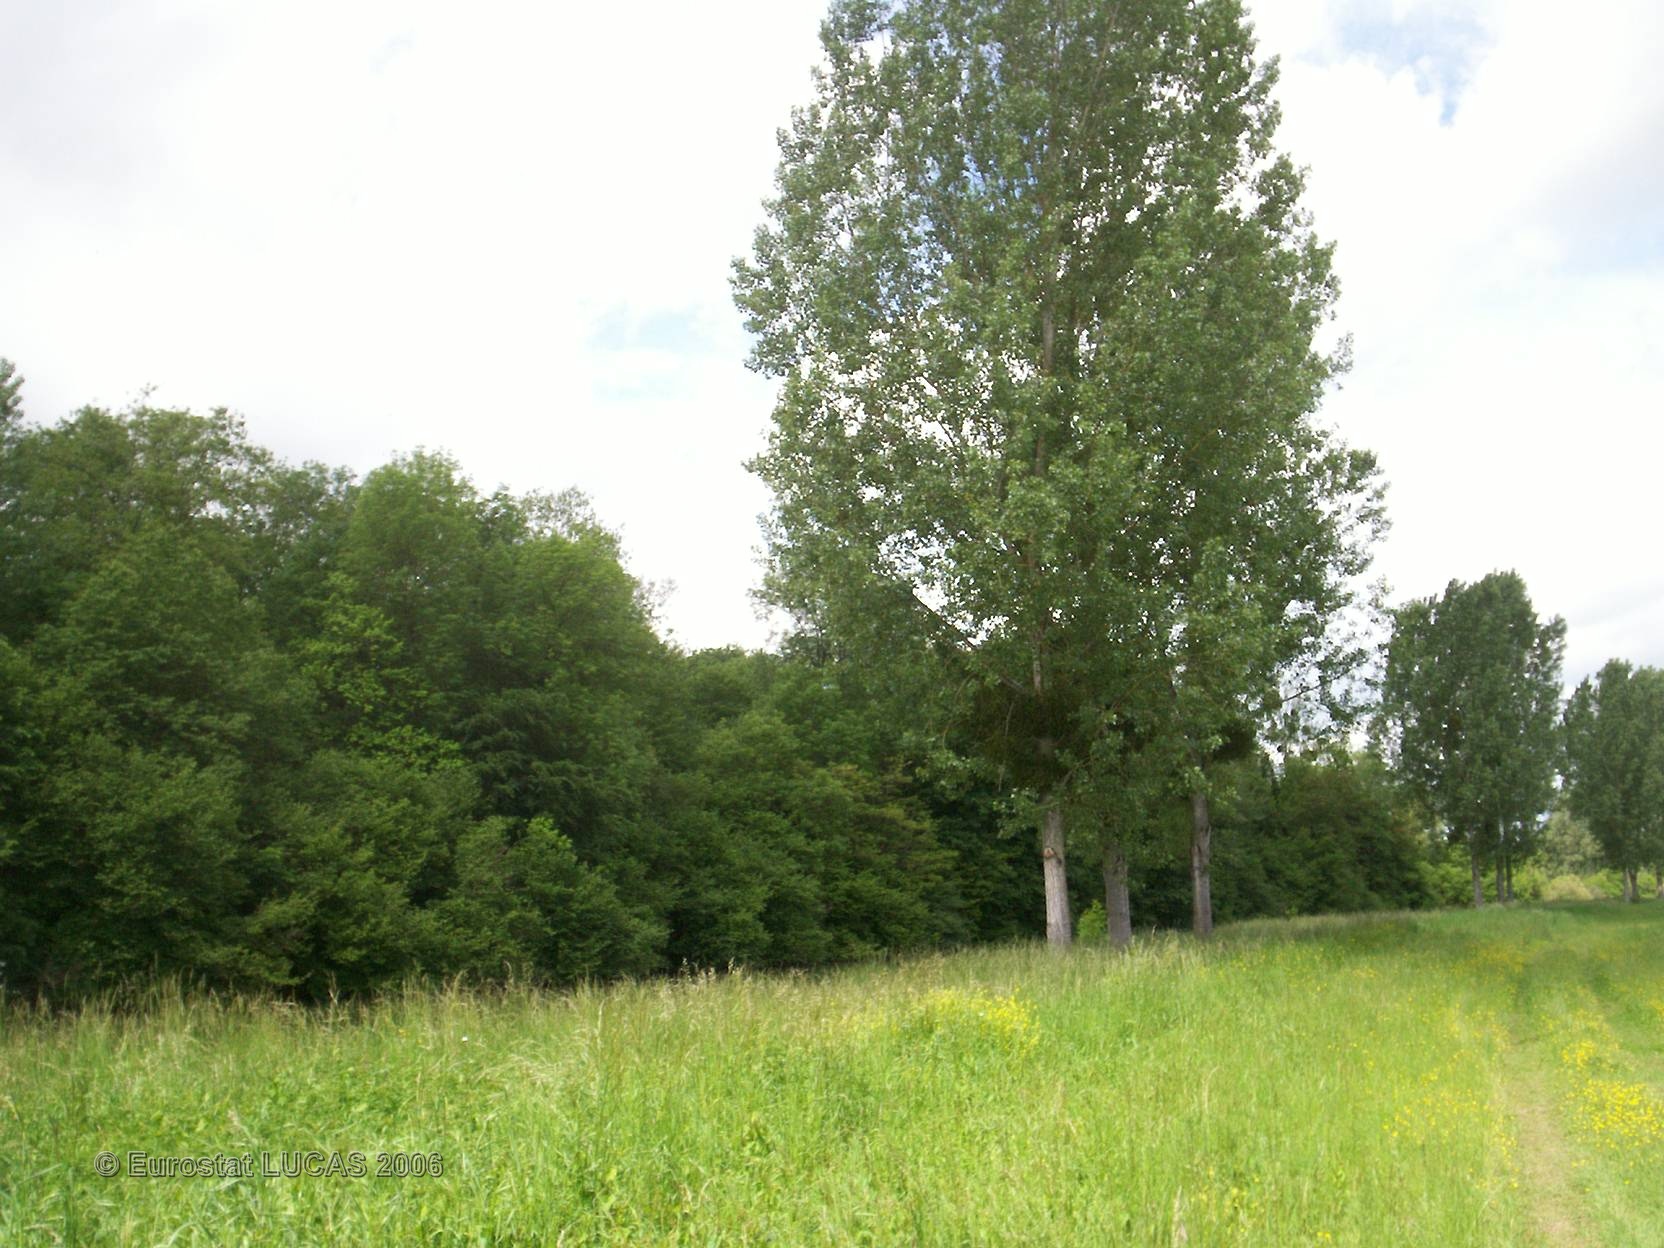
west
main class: Grassland
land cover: Grassland without tree/shrub cover
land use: Agriculture (excluding fallow land and kitchen gardens)
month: May
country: FR
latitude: 49.4881
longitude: 4.4051
